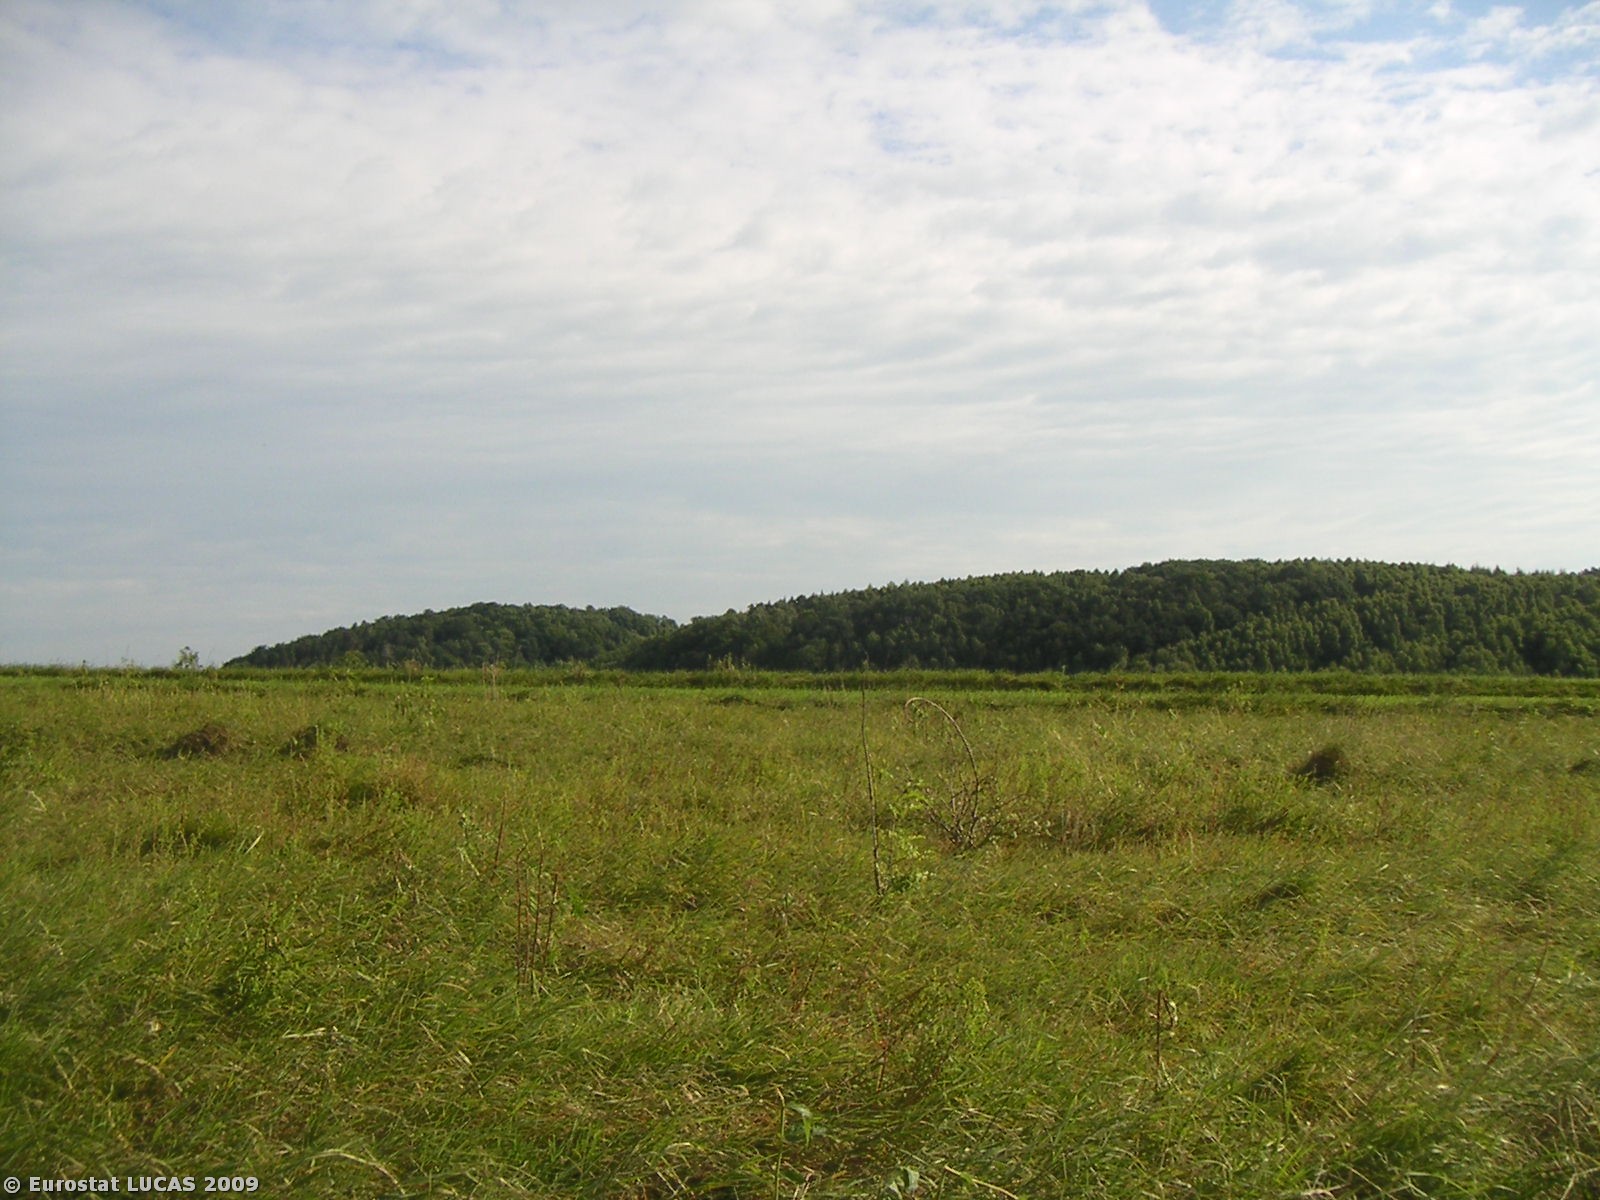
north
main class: Cropland
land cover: Triticale
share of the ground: > 75 %
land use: Agriculture (excluding fallow land and kitchen gardens)
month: June
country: PL
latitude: 50.1632
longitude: 19.7589
